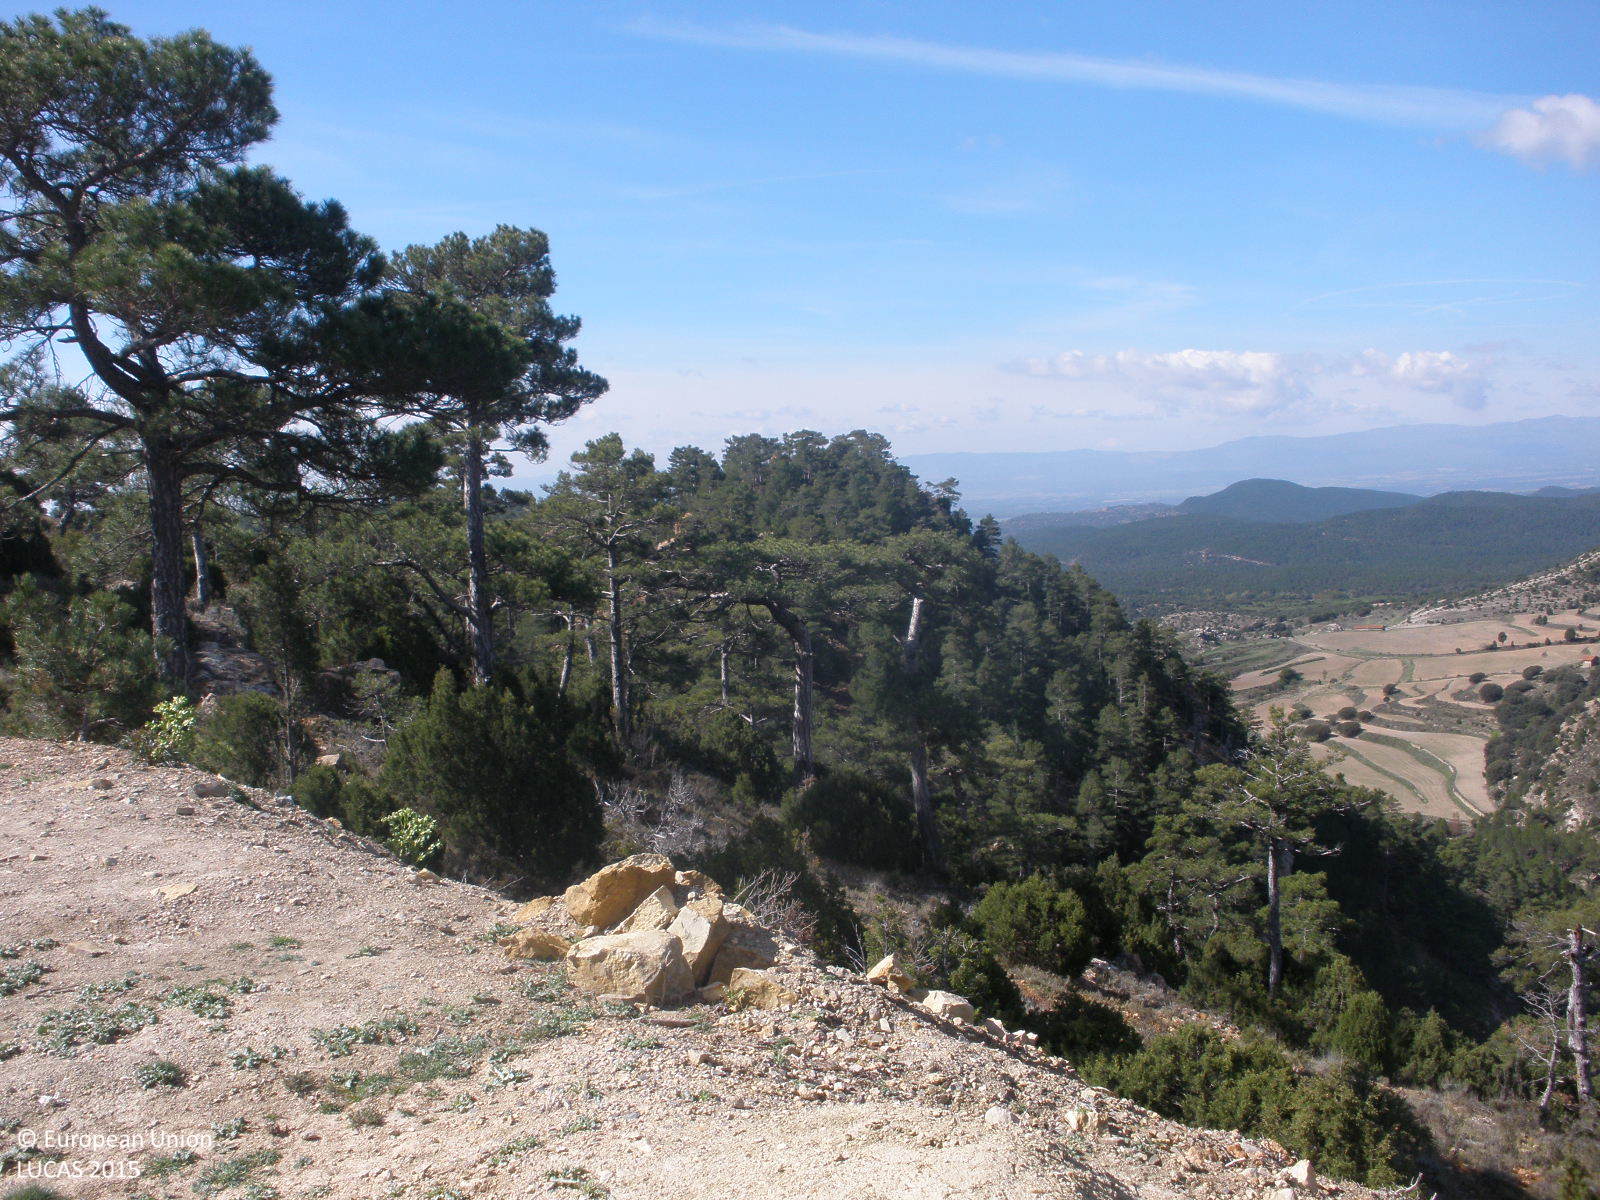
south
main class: Woodland
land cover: Pine dominated coniferous woodland
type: coniferous forest of the mediterranean region
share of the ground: > 75 %
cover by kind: coniferous forest trees 70 %, shrubs 20 %, consolidated bare surface 10 %
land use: Semi-natural and natural areas not in use
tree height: > 5 m
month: April
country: ES
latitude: 40.3156
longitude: -0.7281
